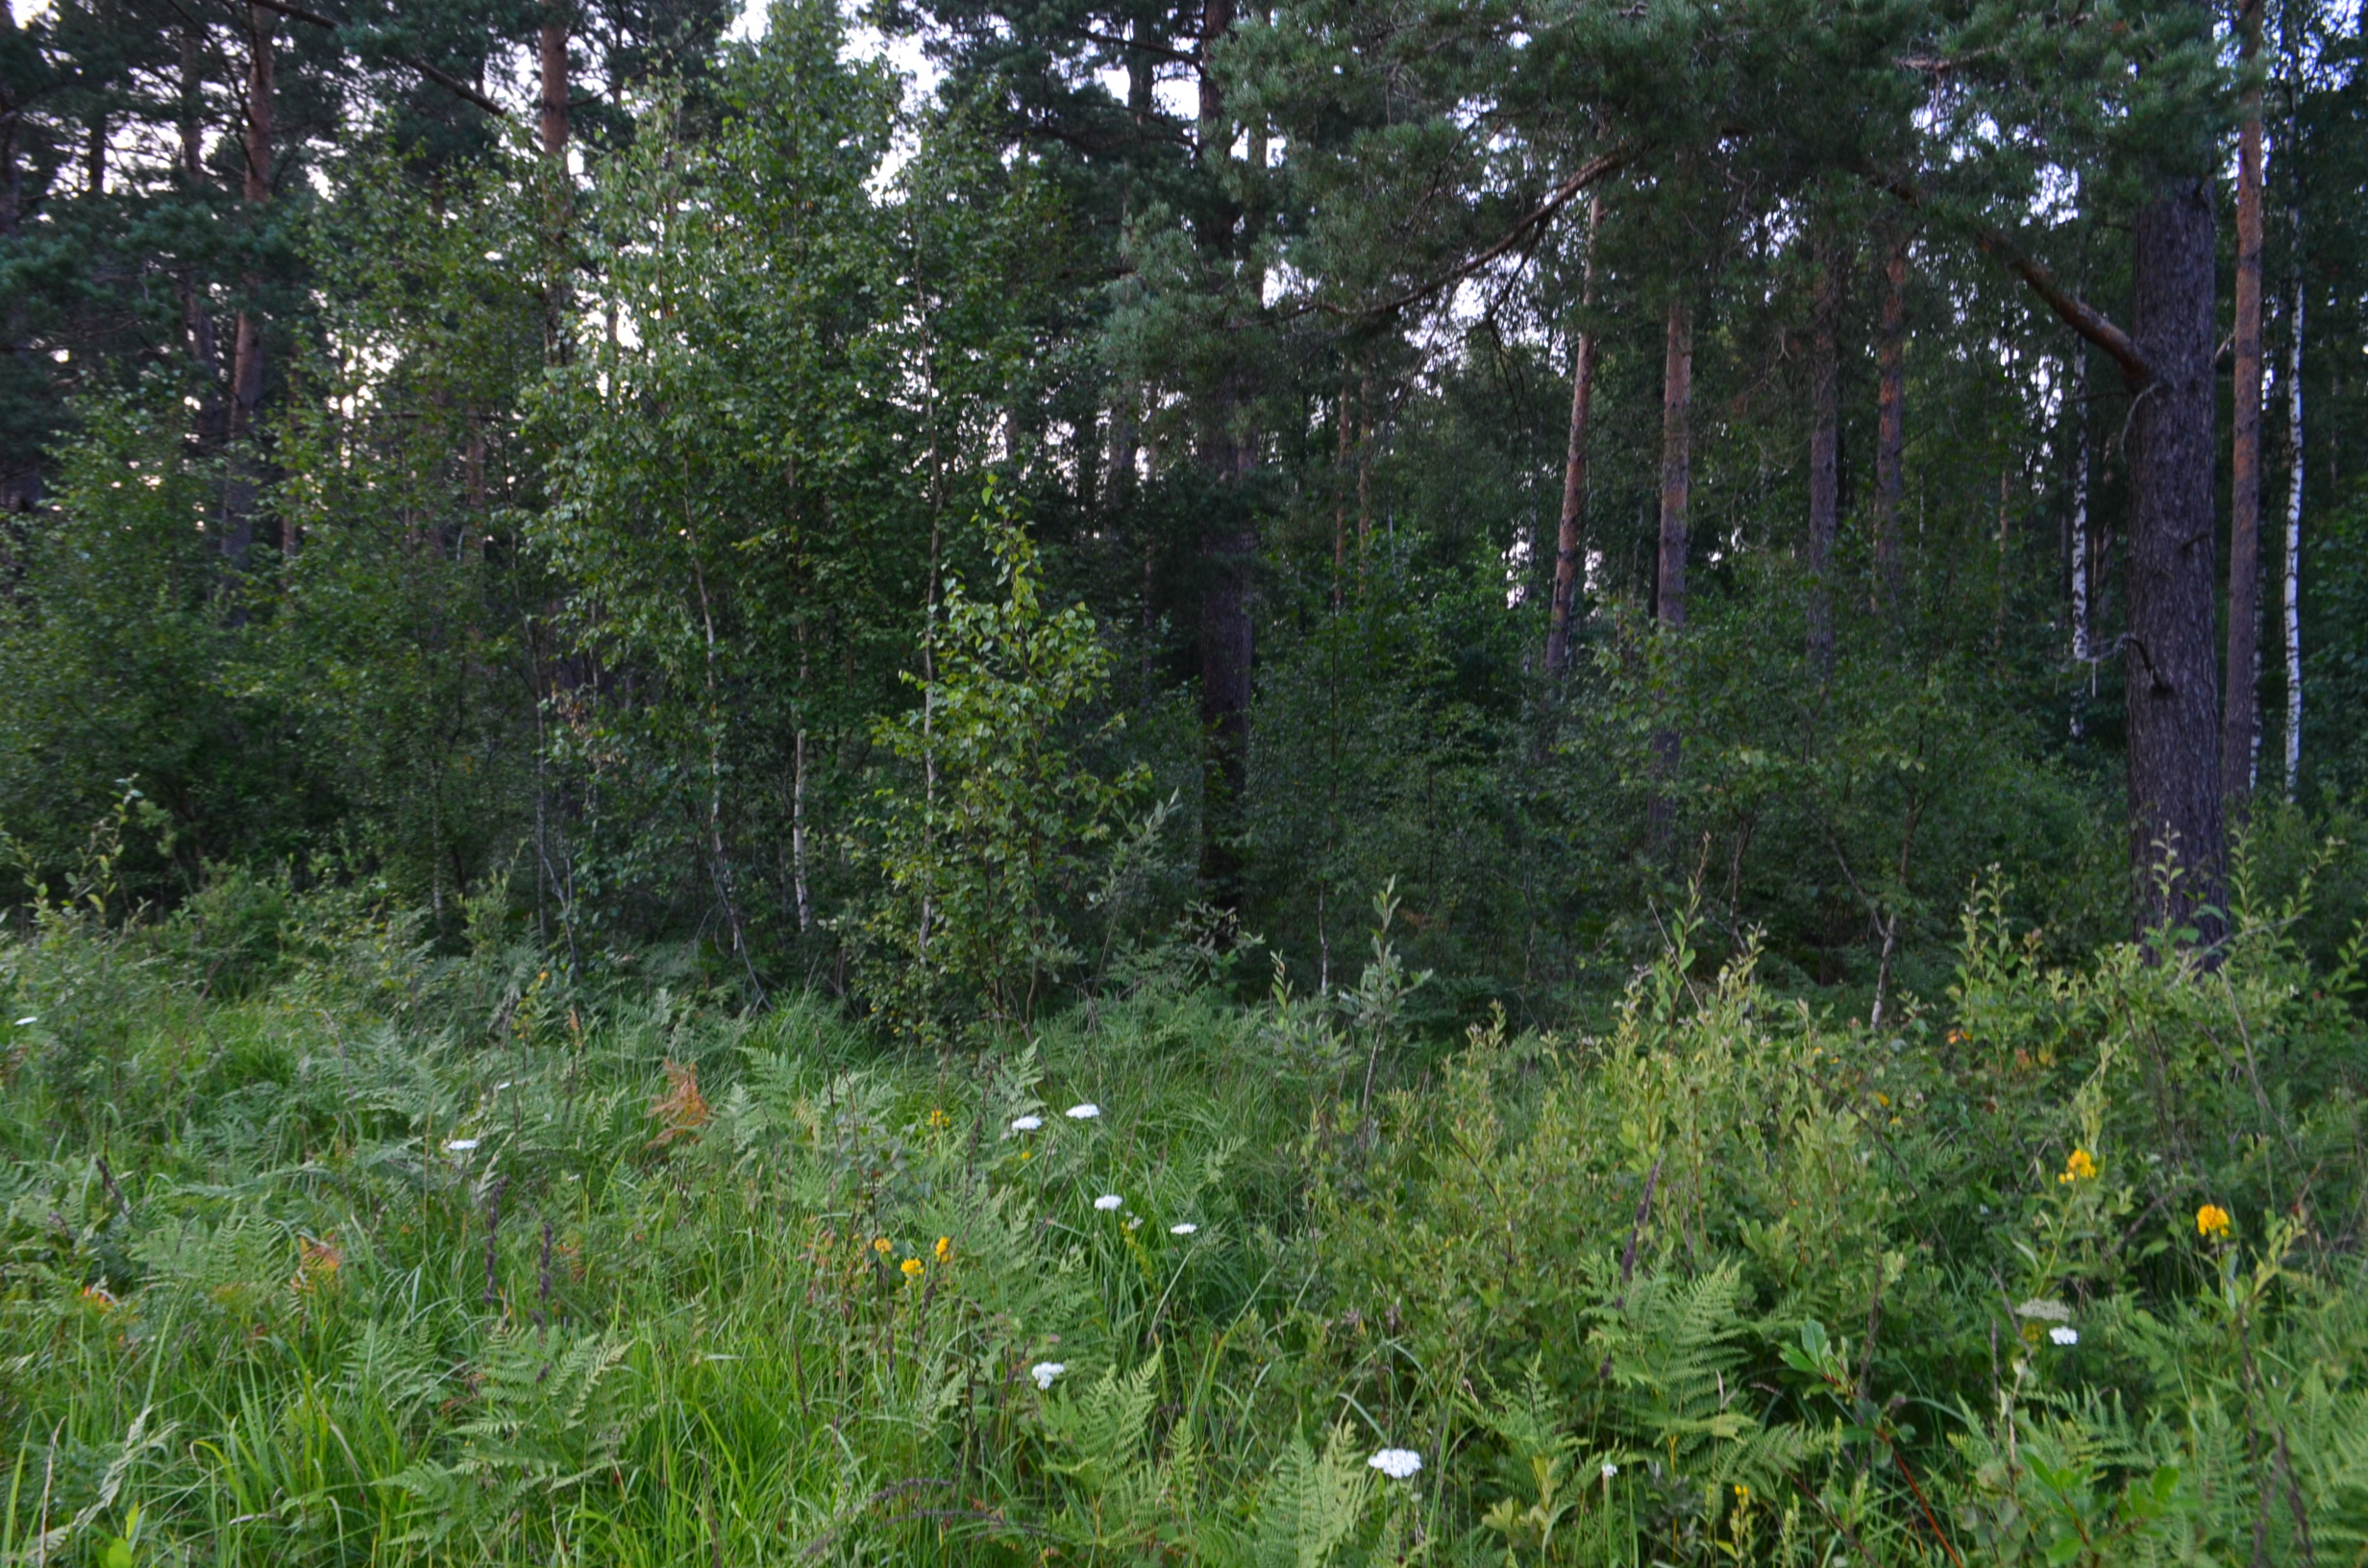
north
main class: Woodland
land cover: Pine dominated mixed woodland
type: hemiboreal forest and nemoral coniferous forest and mixed broadleaved-coniferous forest
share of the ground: > 75 %
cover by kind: broadleaved forest trees 55 %, coniferous forest trees 40 %, herbaceous plants 4 %, shrubs 1 %
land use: Forestry
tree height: > 5 m
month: August
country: LV
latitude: 57.4200
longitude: 21.6460
